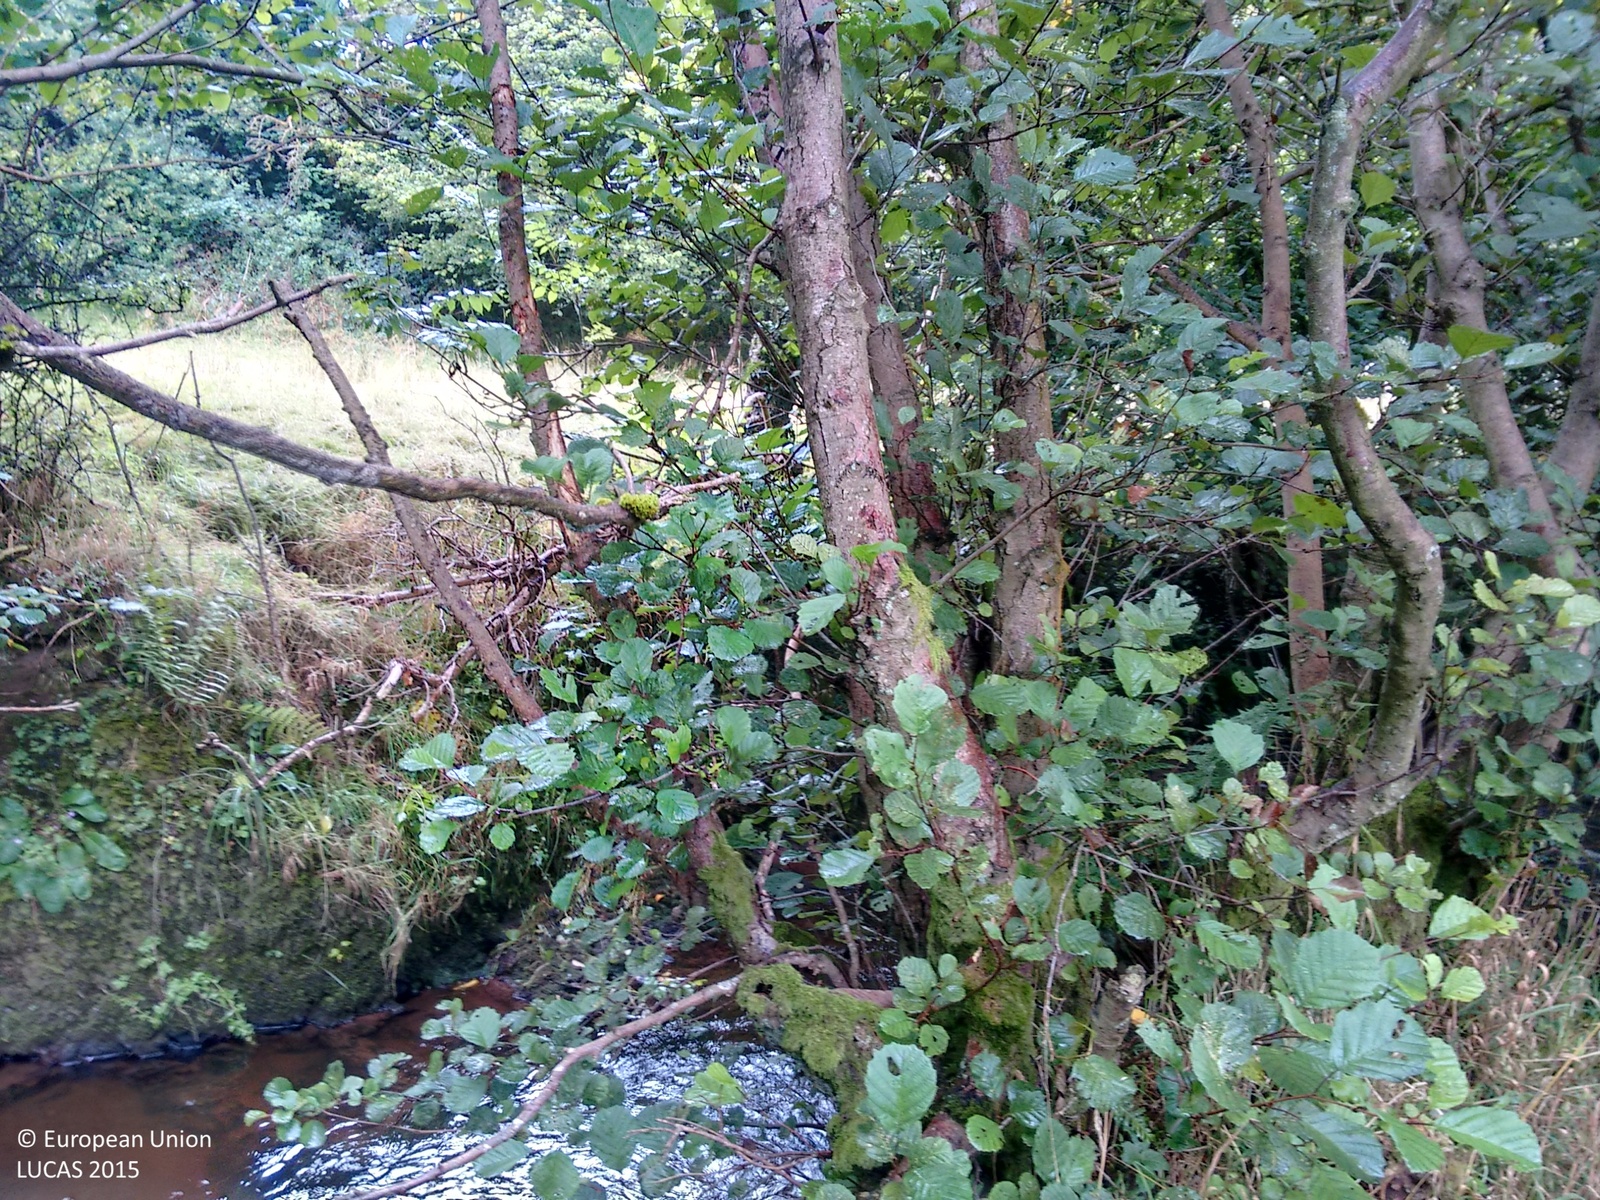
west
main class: Woodland
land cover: Other mixed woodland
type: mesophytic deciduous forest
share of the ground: > 75 %
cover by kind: broadleaved forest trees 60 %, coniferous forest trees 40 %
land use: Forestry
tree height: > 5 m
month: September
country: GB
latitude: 52.5425
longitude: -2.9164
